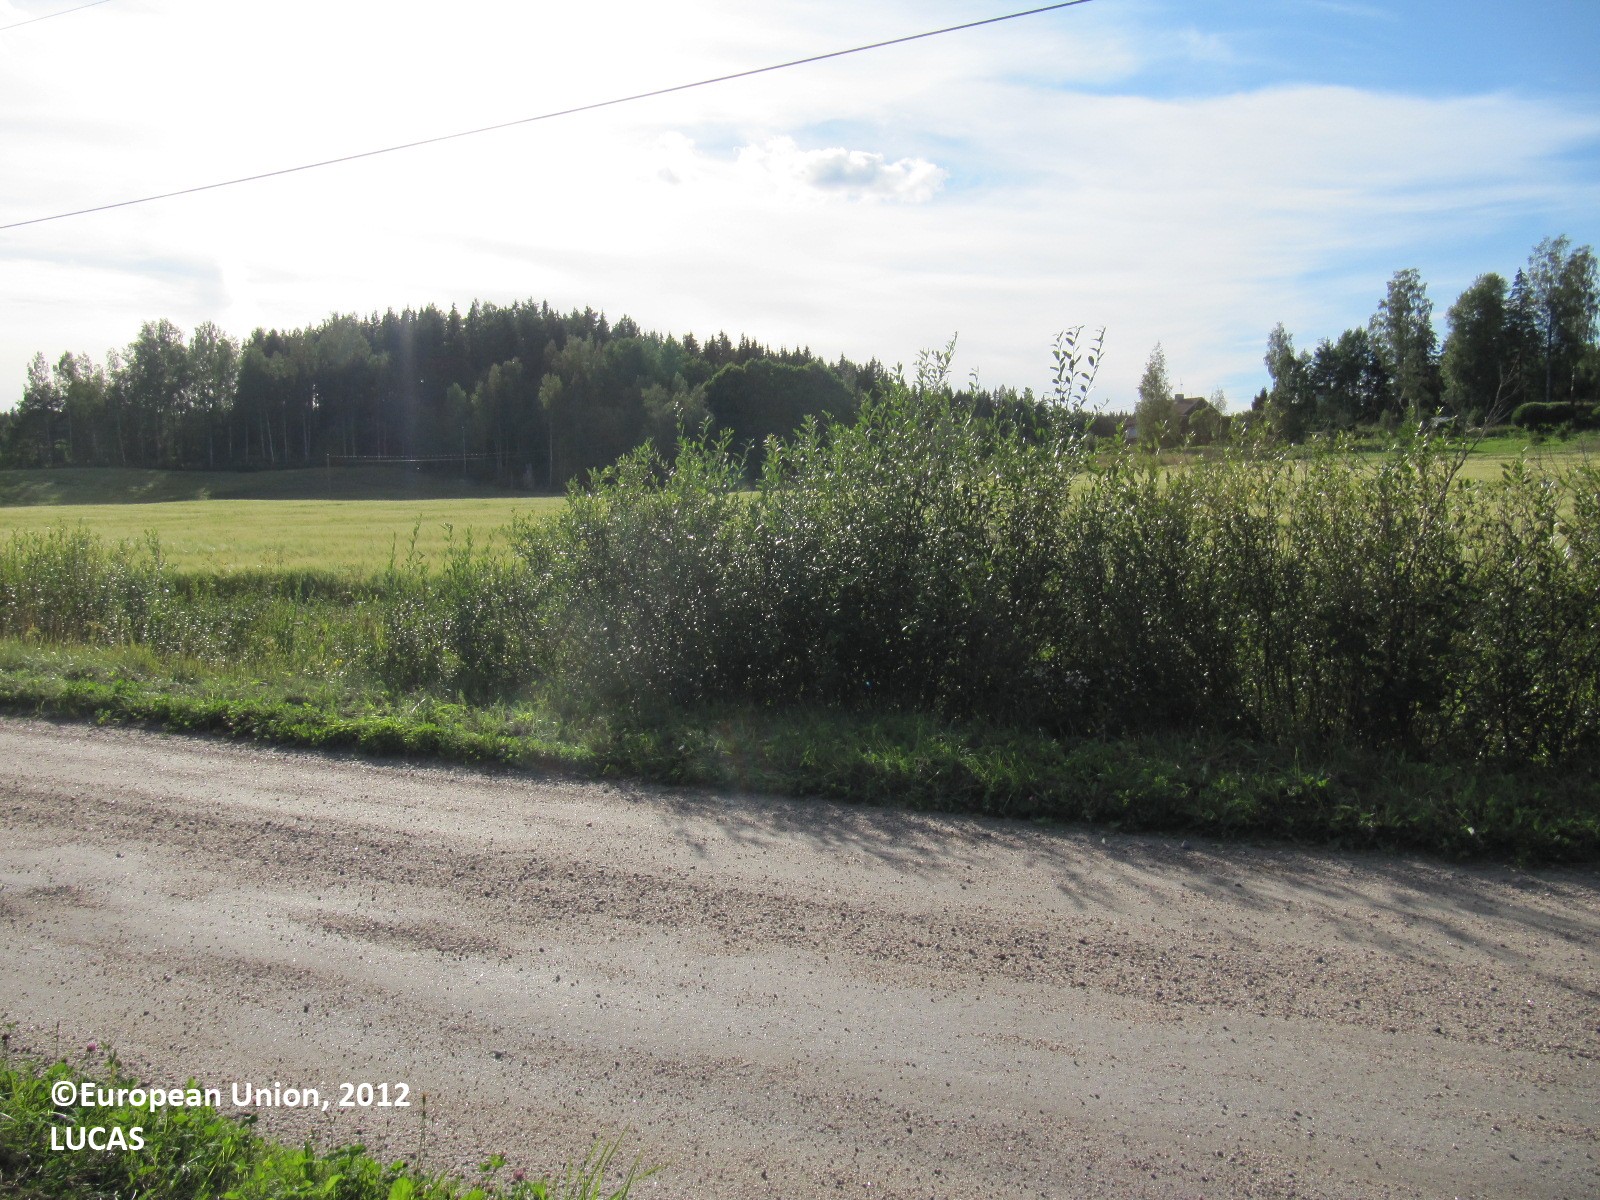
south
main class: Cropland
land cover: Barley
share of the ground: > 75 %
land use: Agriculture (excluding fallow land and kitchen gardens)
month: August
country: FI
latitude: 60.3097
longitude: 23.1681
